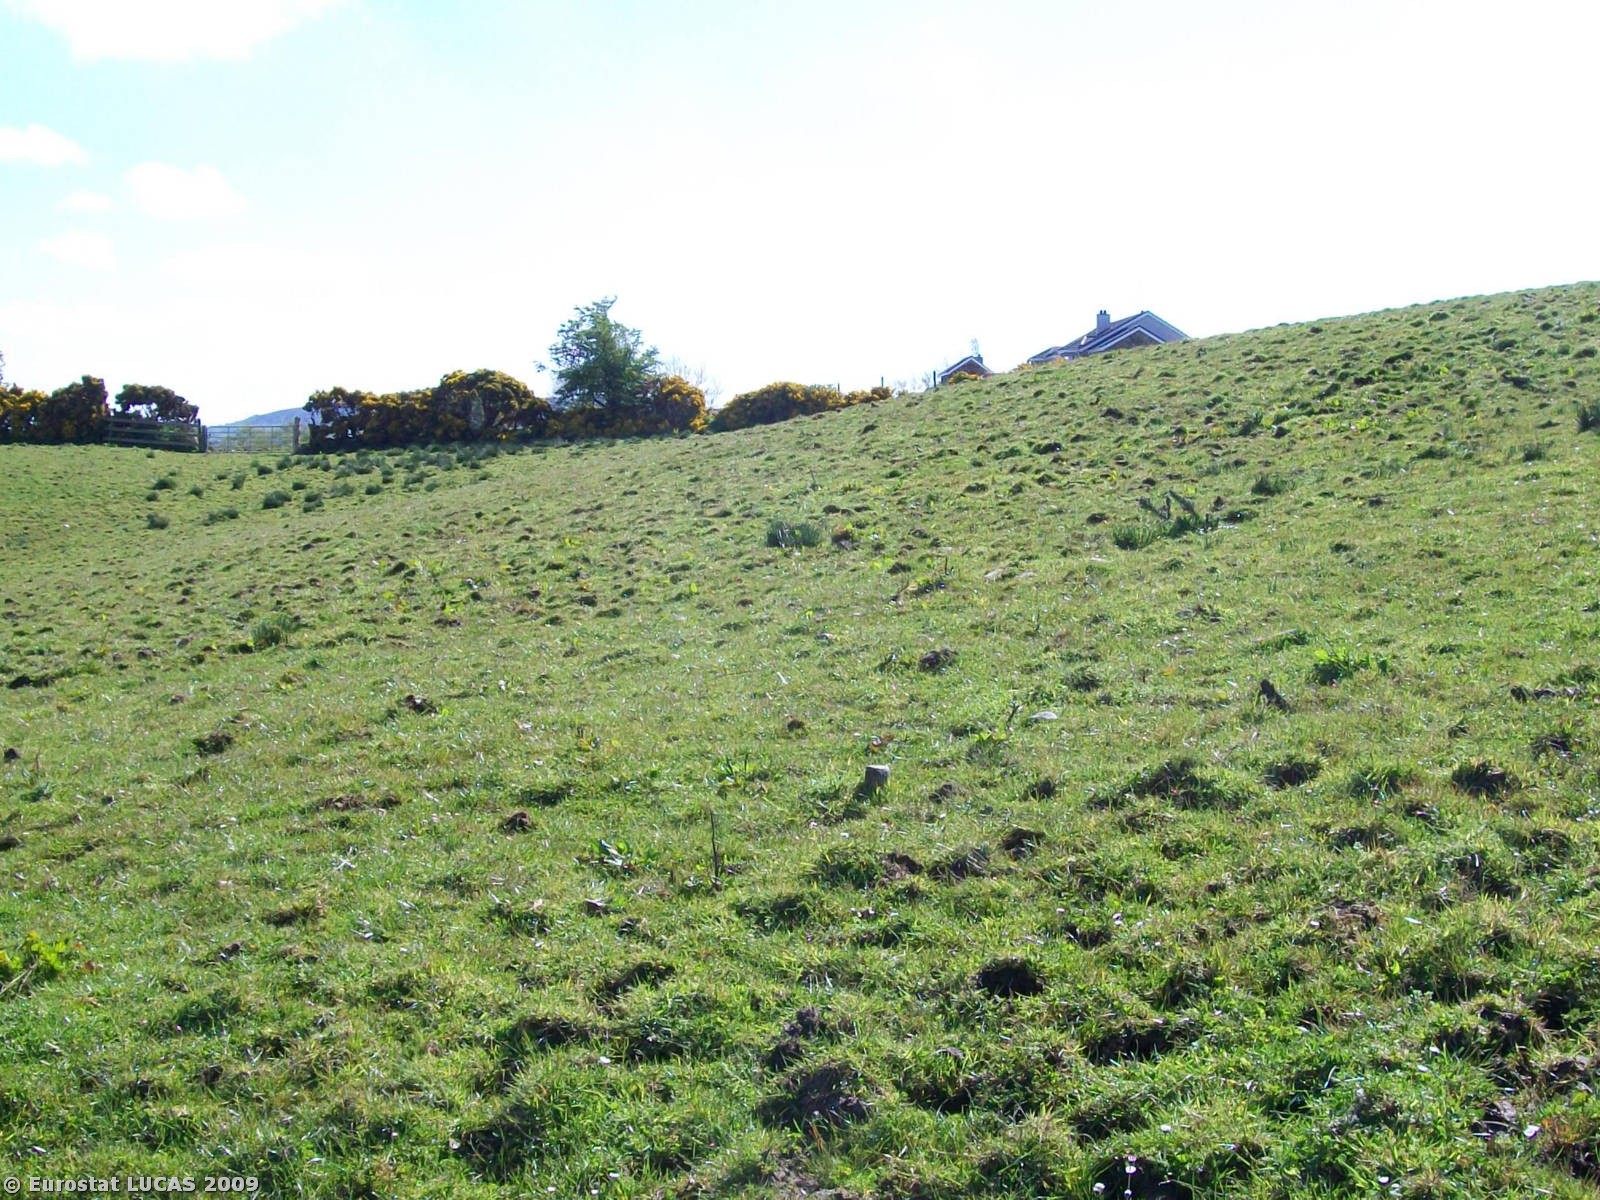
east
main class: Grassland
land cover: Grassland without tree/shrub cover
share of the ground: > 75 %
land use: Agriculture (excluding fallow land and kitchen gardens)
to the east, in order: Grassland without tree/shrub cover; Managed hedges; Fences; Grassland with sparse tree/shrub cover; Fences; Tracks; Fences; Railways; Artificial constructions in urban areas; Managed hedges; Fences; Grassland without tree/shrub cover; Fences; Abandoned hedges; Grassland without tree/shrub cover
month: May
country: GB
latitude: 54.7086
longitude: -7.3950
